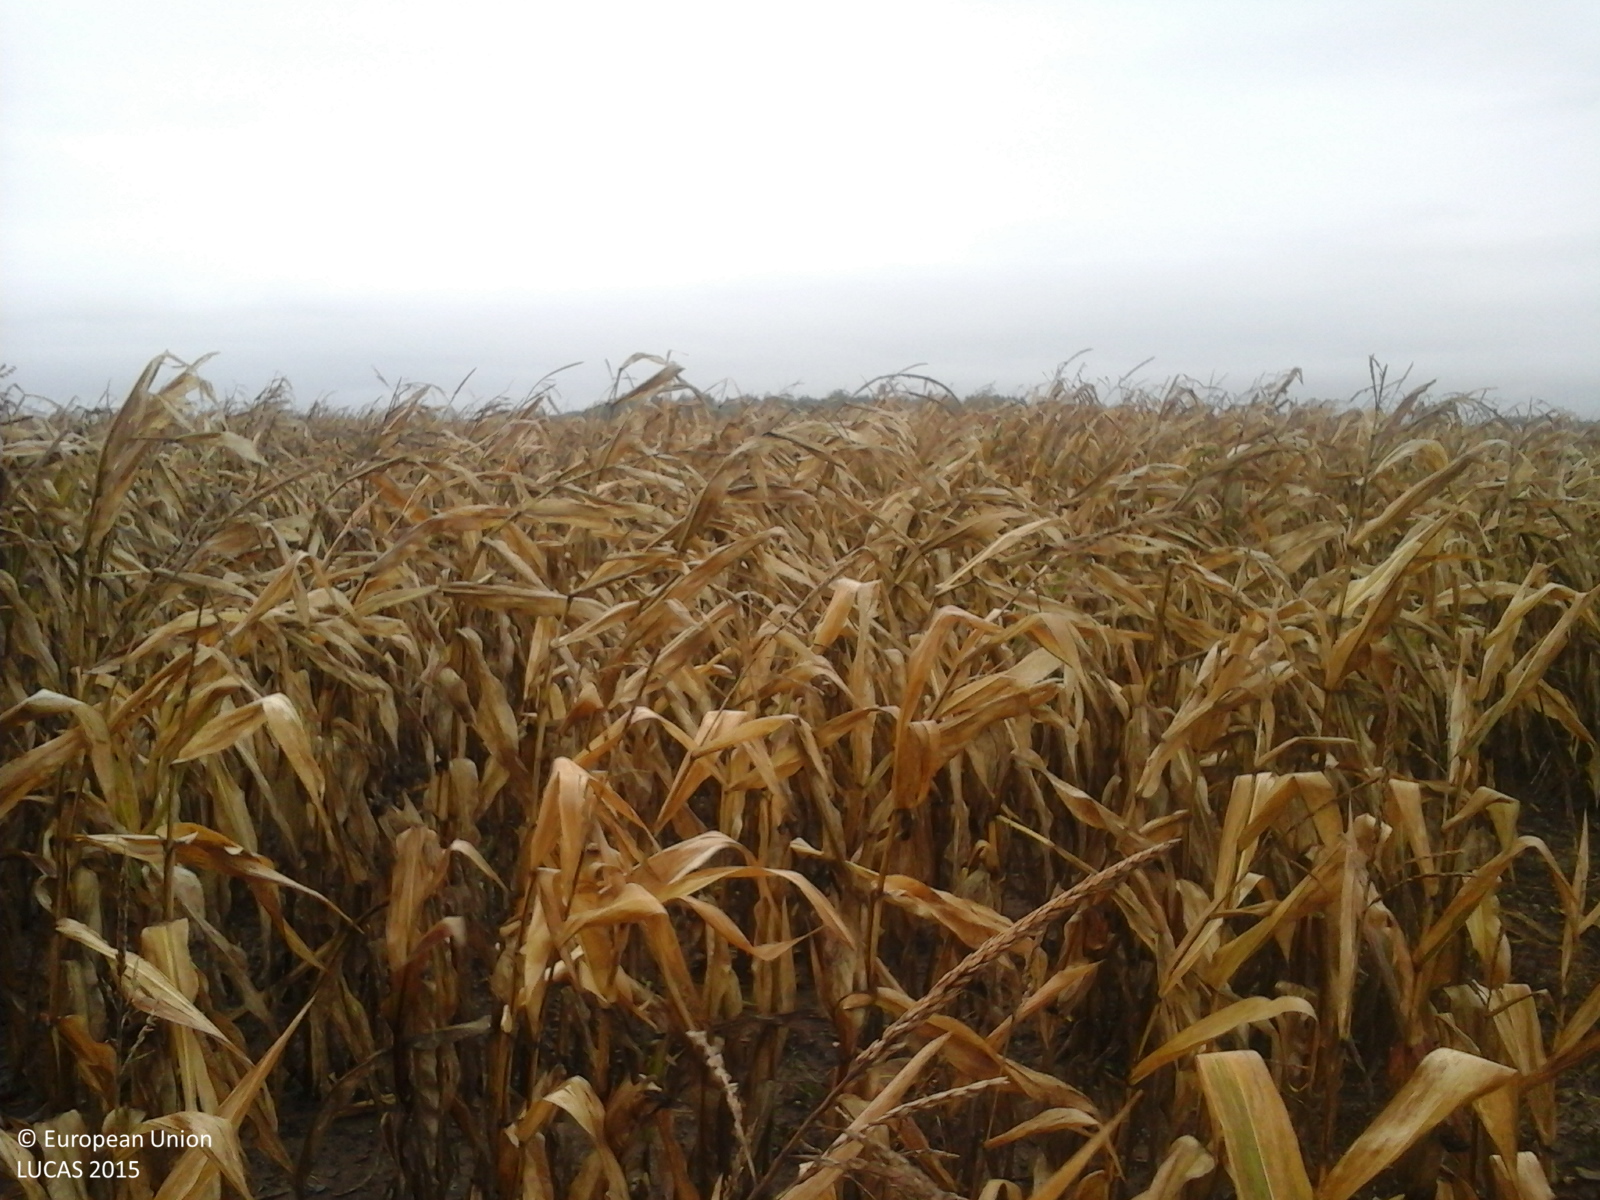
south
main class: Cropland
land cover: Maize
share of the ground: > 75 %
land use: Agriculture (excluding fallow land and kitchen gardens)
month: October
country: RO
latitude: 45.7846
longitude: 24.7107
